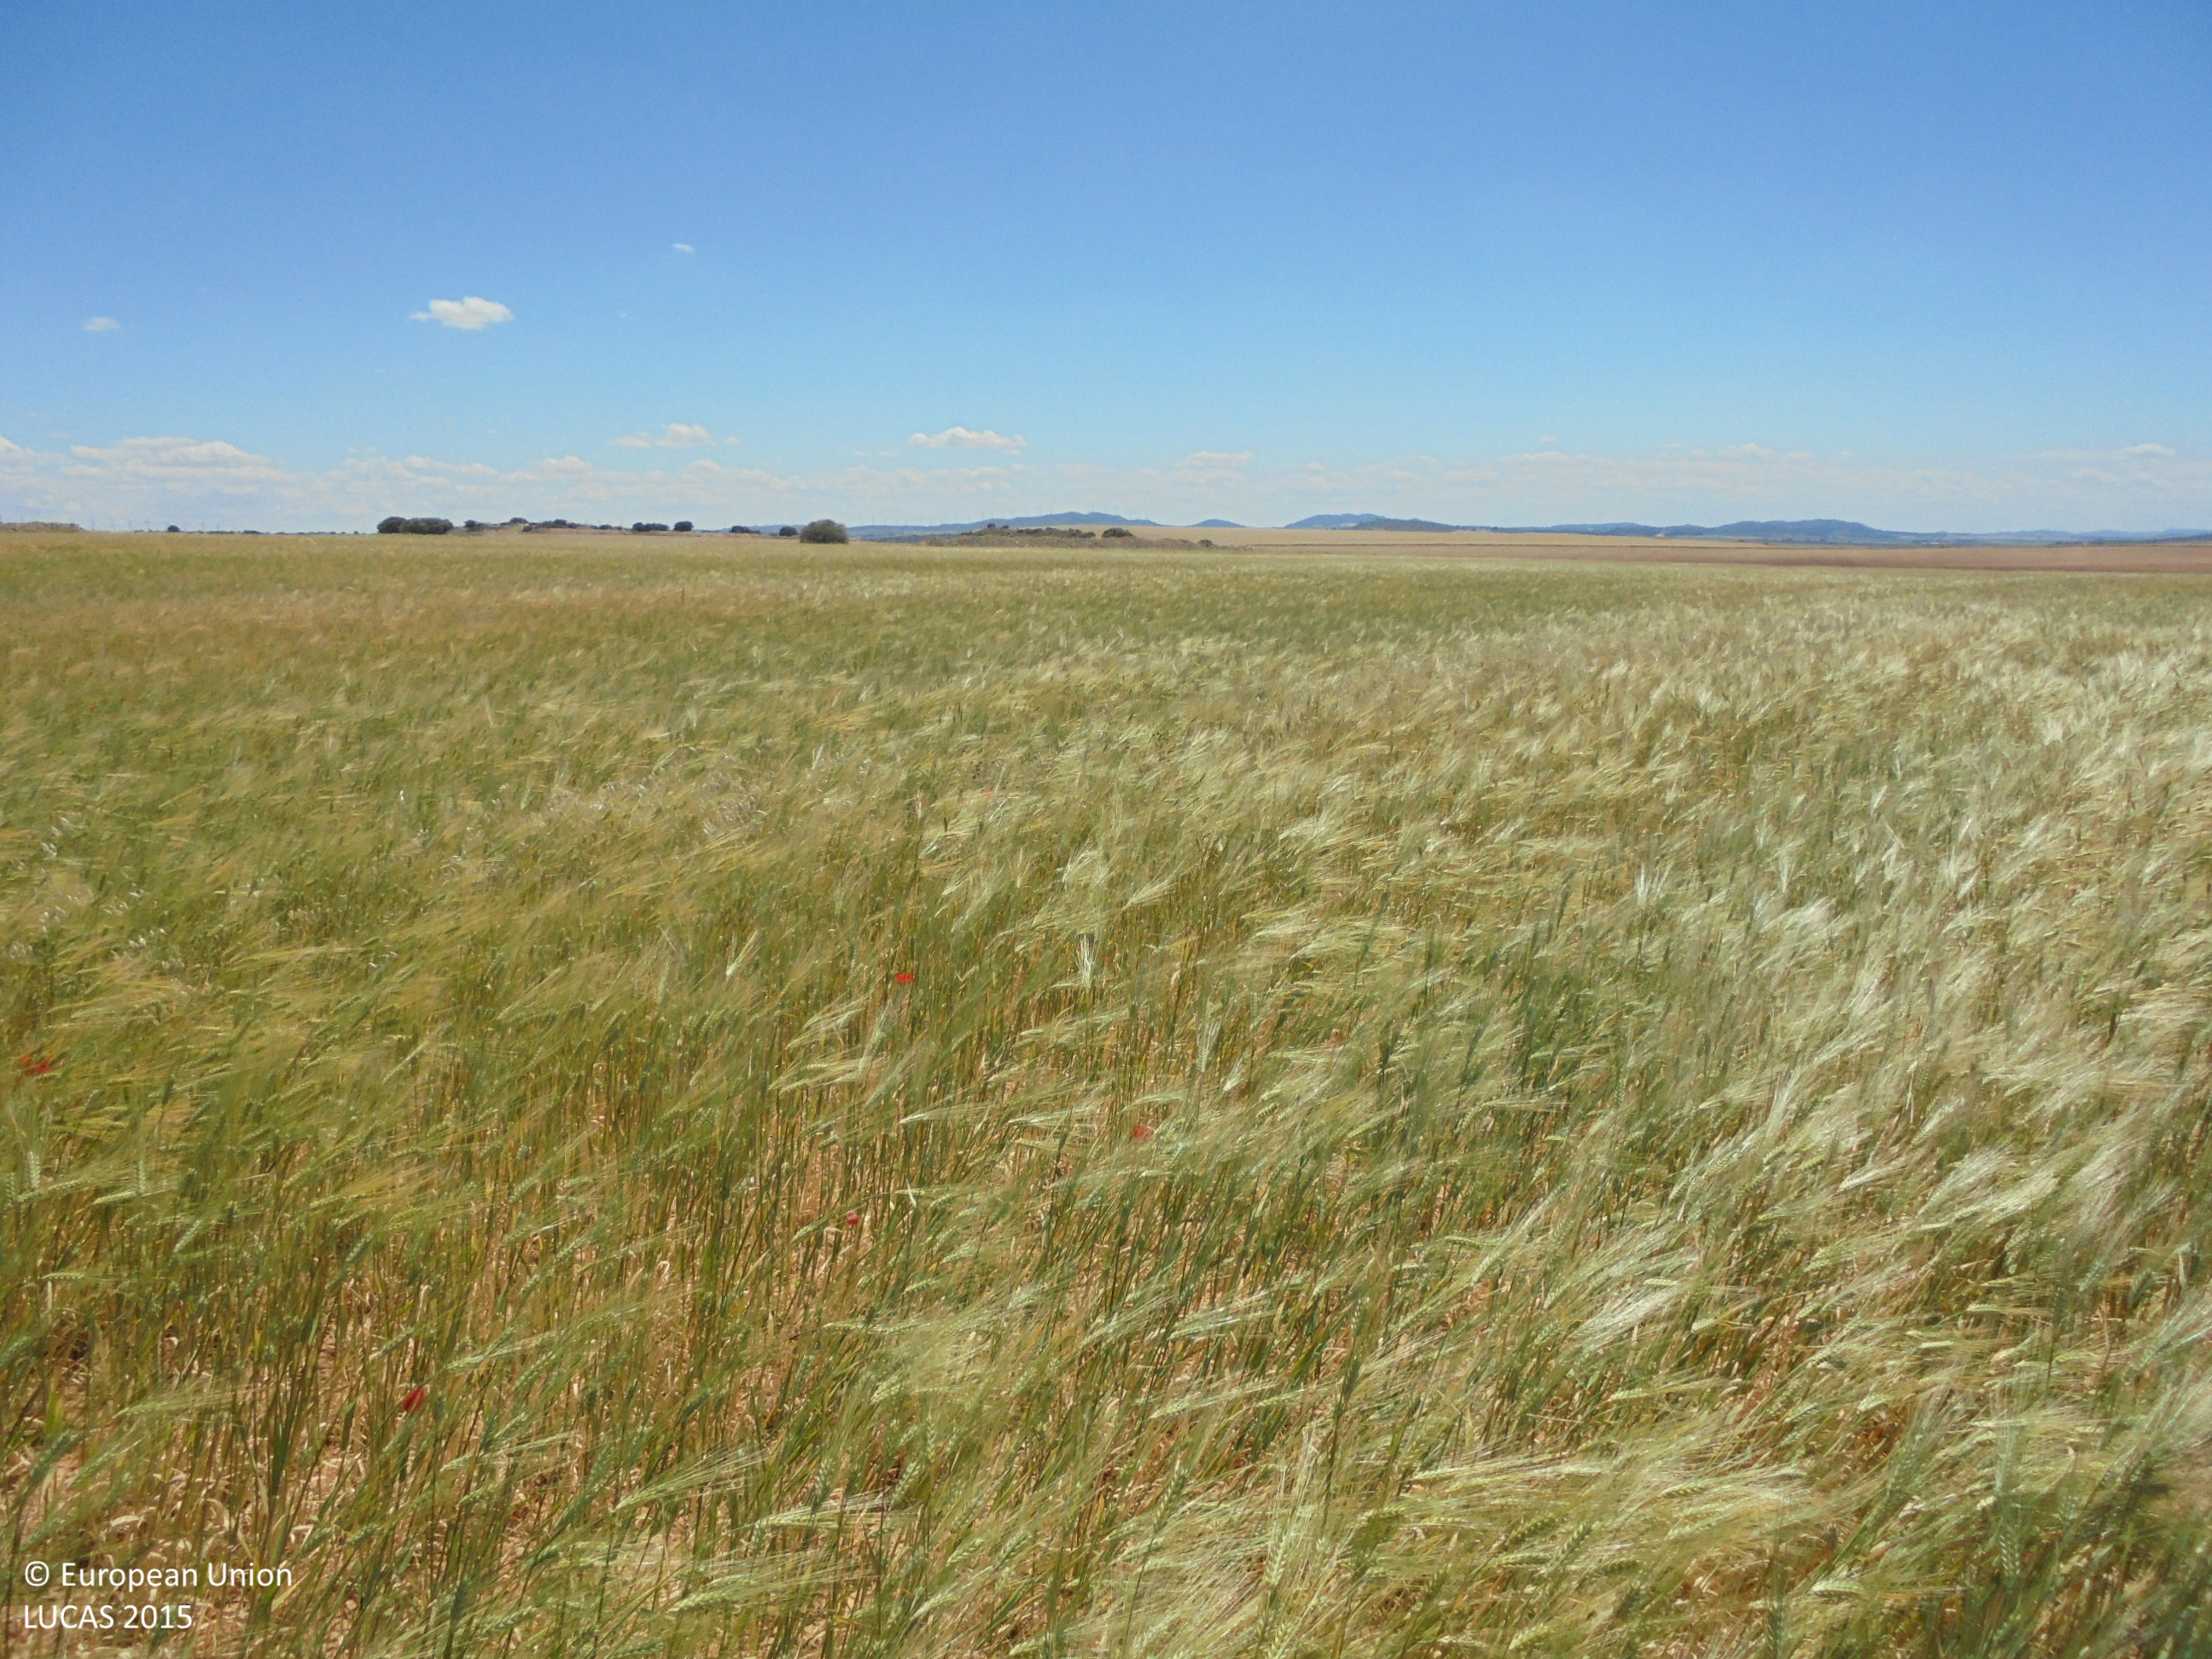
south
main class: Cropland
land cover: Barley
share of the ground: > 75 %
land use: Agriculture (excluding fallow land and kitchen gardens)
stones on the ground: < 10 %
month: May
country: ES
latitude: 38.8832
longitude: -1.7451
